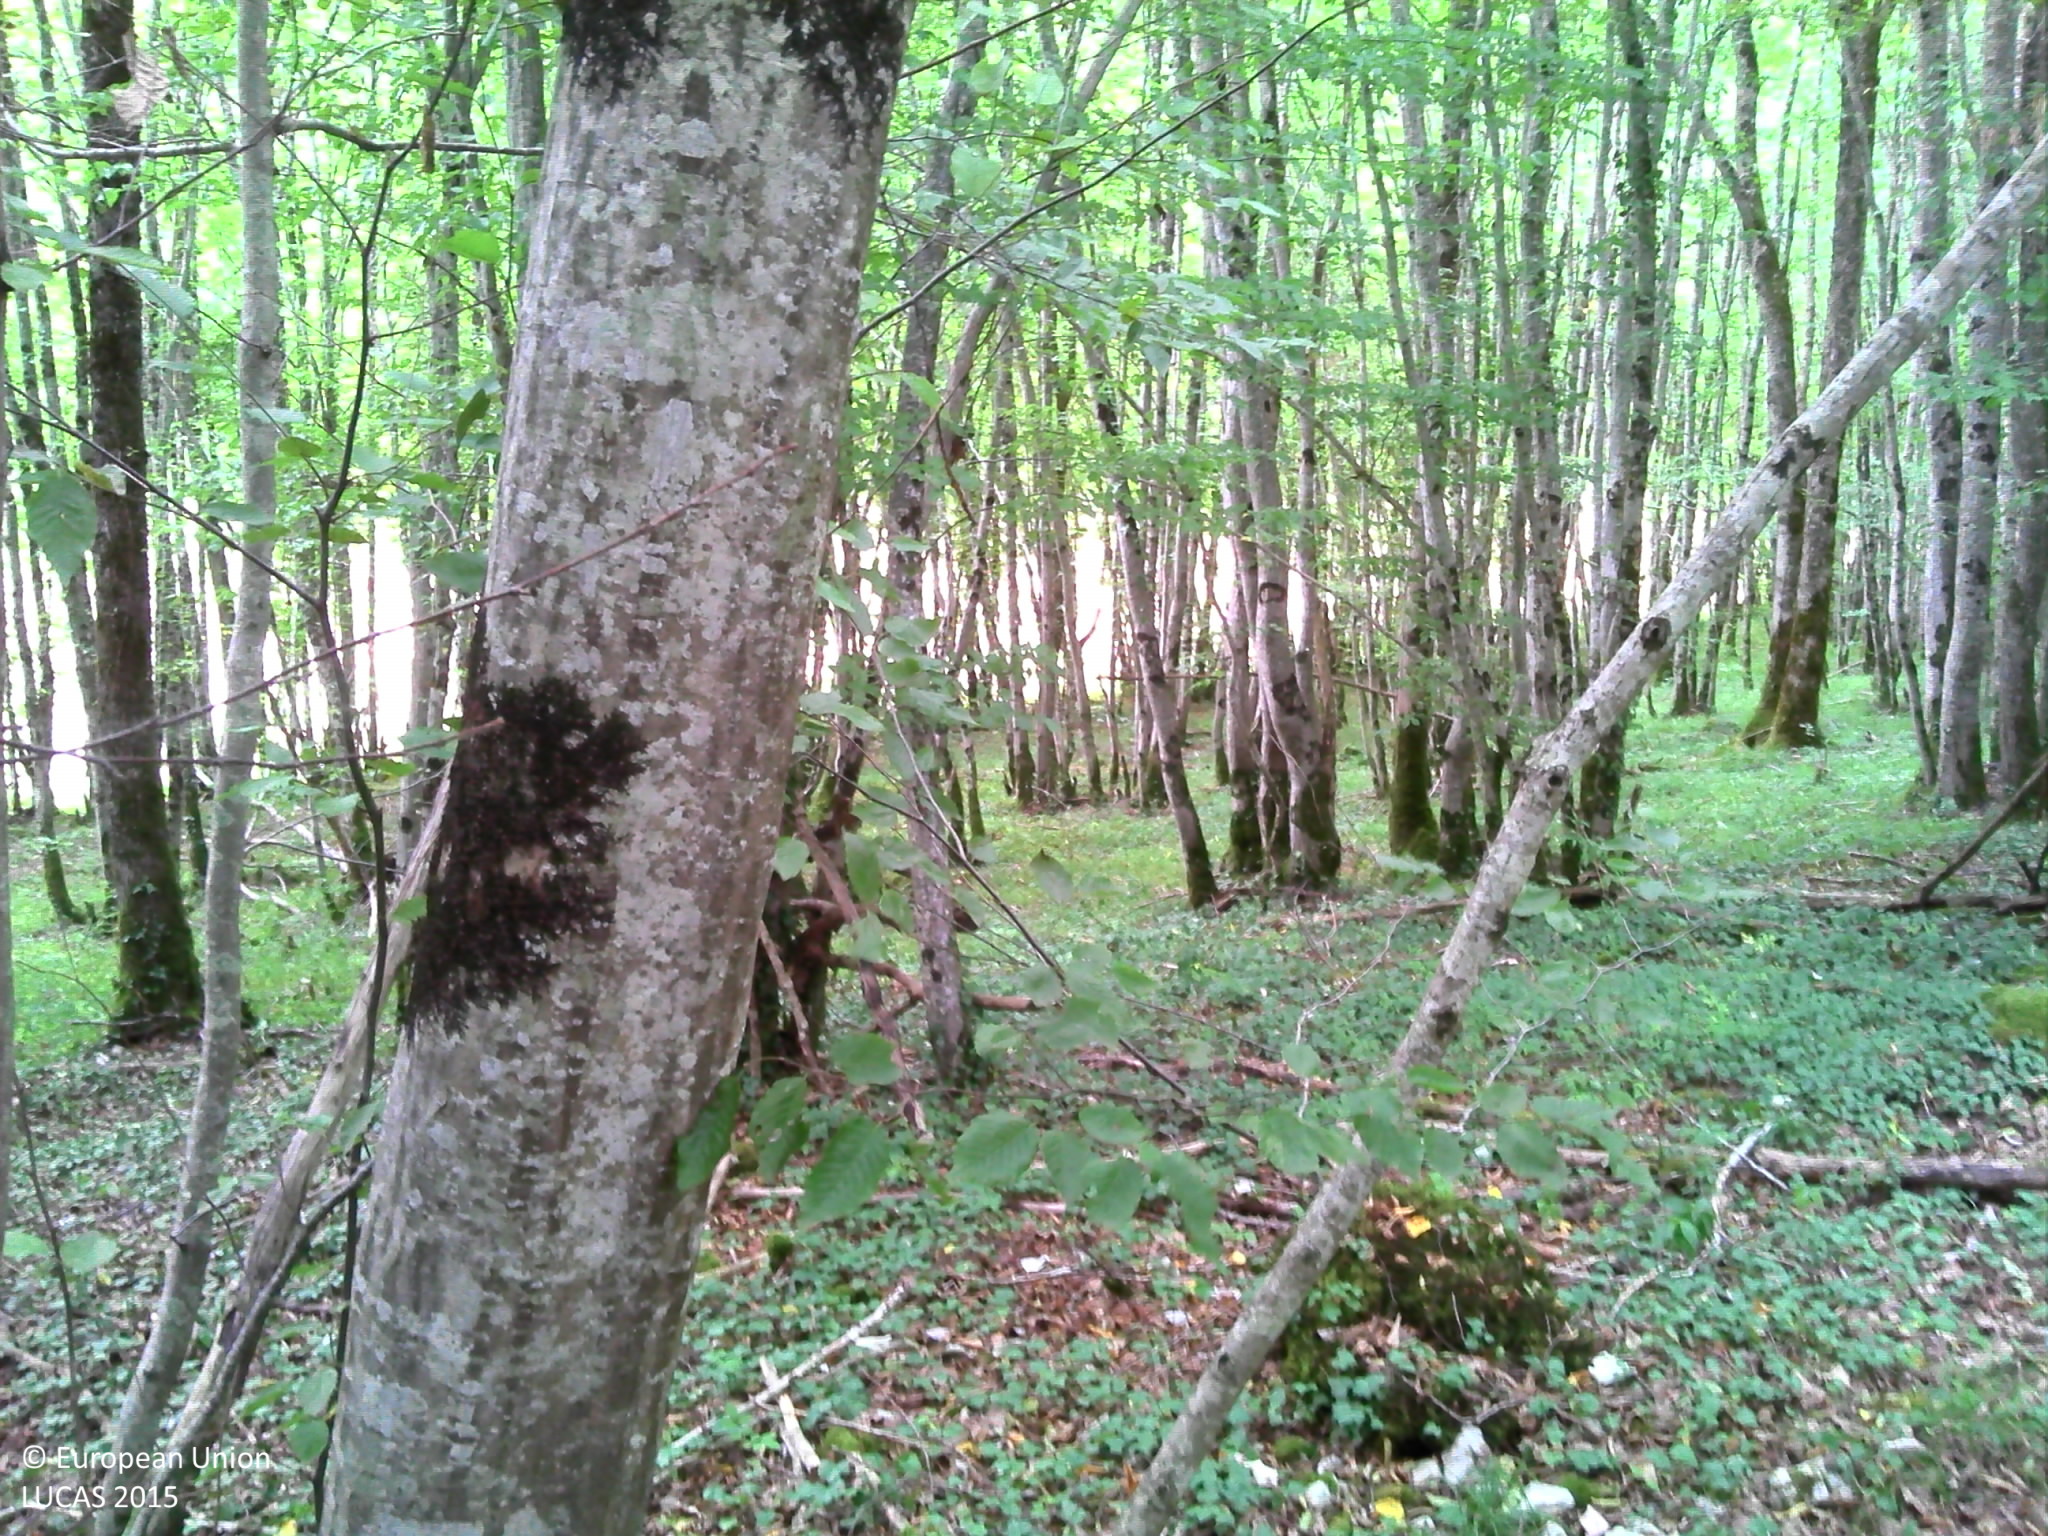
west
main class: Woodland
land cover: Broadleaved woodland
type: mesophytic deciduous forest
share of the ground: > 75 %
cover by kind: broadleaved forest trees 90 %, herbaceous plants 5 %, lichens and mosses 5 %
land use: Forestry
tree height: > 5 m
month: August
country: FR
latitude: 47.6856
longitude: 4.7904
